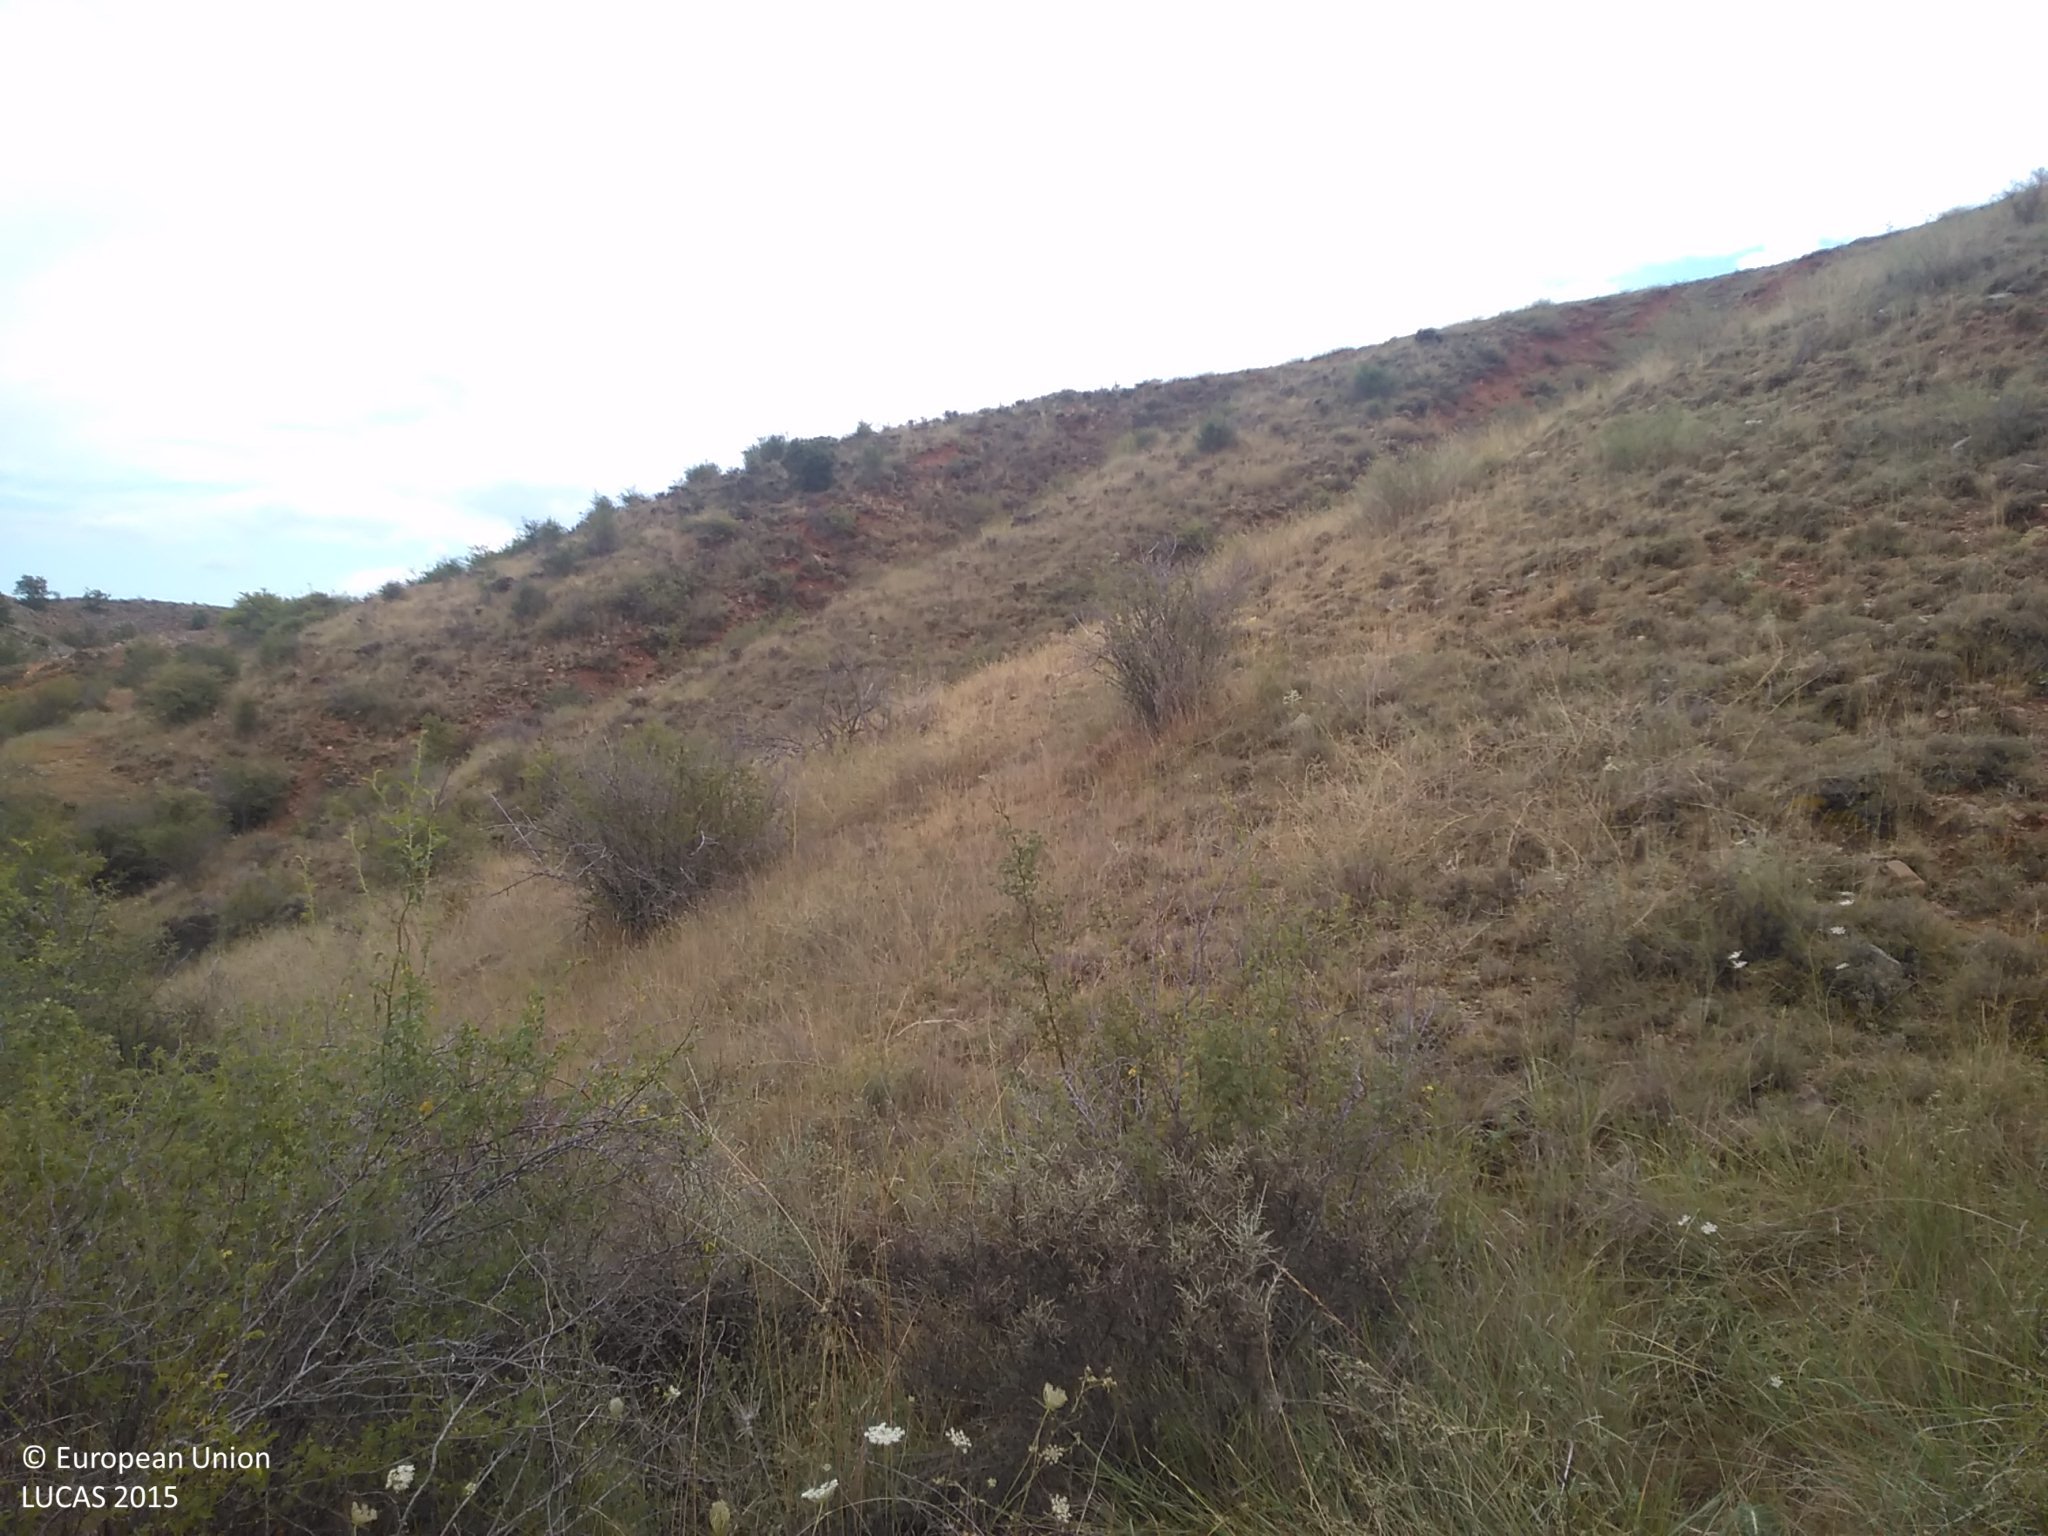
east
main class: Shrubland
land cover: Shrubland without tree cover
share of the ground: 50 - 75 %
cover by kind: shrubs 70 %, herbaceous plants 30 %
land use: Semi-natural and natural areas not in use
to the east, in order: Shrubland without tree cover; Shrubland with sparse tree cover
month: July
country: ES
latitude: 41.4290
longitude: -1.9837
